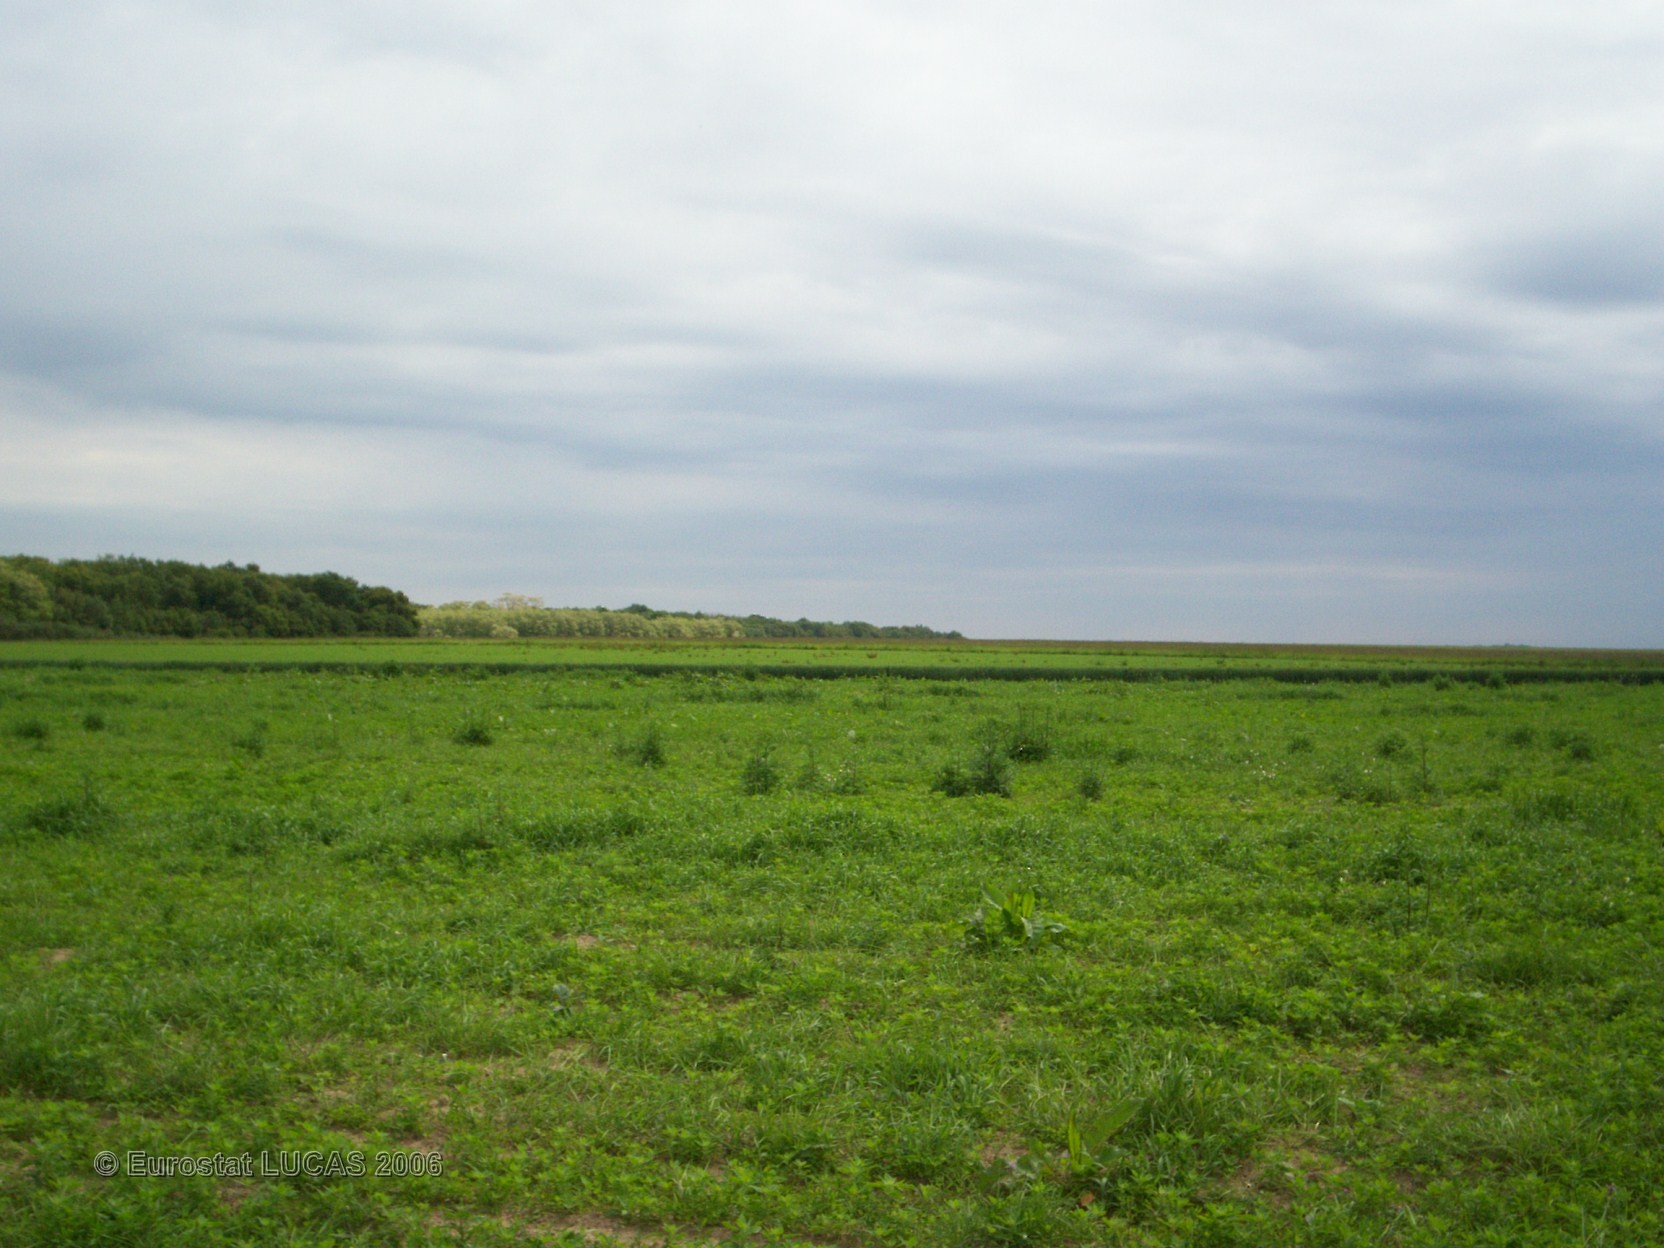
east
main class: Grassland
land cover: Grassland without tree/shrub cover
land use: Agriculture (excluding fallow land and kitchen gardens)
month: June
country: FR
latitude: 49.4279
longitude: 2.7232
